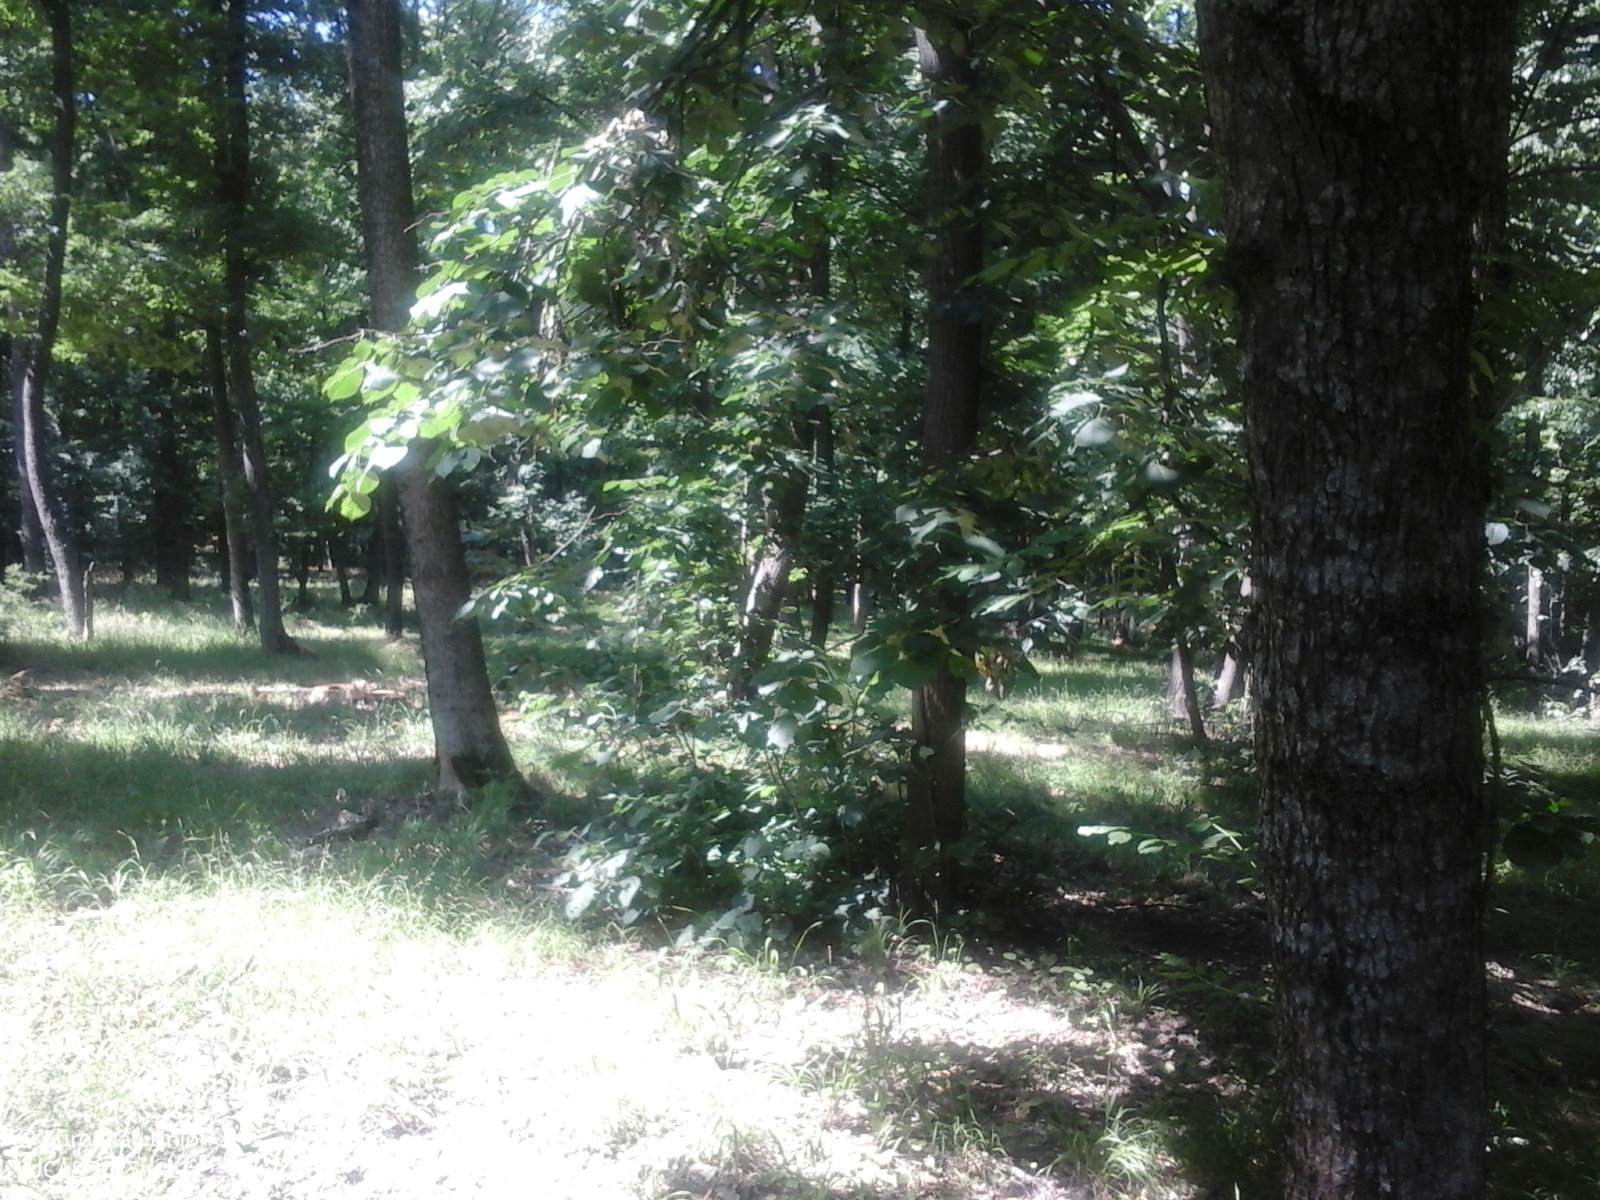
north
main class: Woodland
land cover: Broadleaved woodland
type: beech forest
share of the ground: > 75 %
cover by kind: broadleaved forest trees 85 %, herbaceous plants 15 %
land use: Forestry
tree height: > 5 m
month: June
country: RO
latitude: 46.8401
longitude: 27.8656
